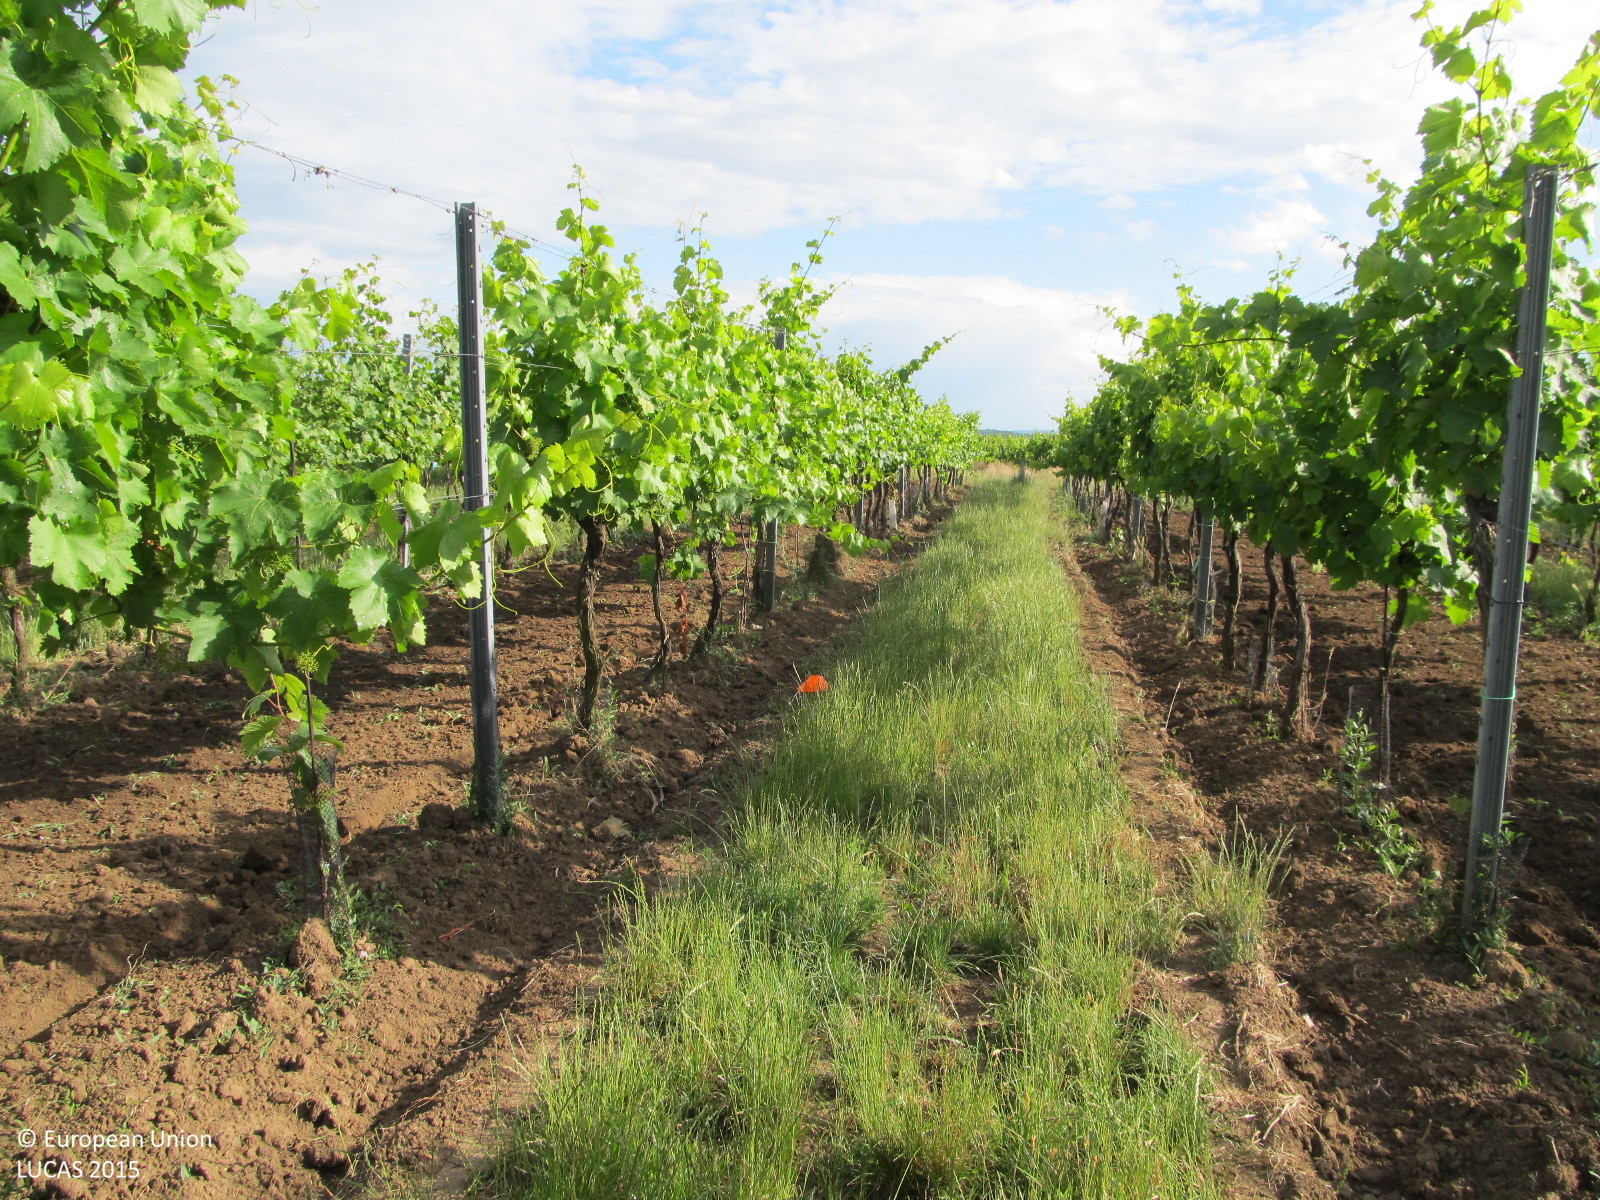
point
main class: Cropland
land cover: Vineyards
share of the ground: 25 - 50 %
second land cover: Grassland without tree/shrub cover
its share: 50 - 75 %
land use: Agriculture (excluding fallow land and kitchen gardens)
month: June
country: AT
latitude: 48.7397
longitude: 16.1104
